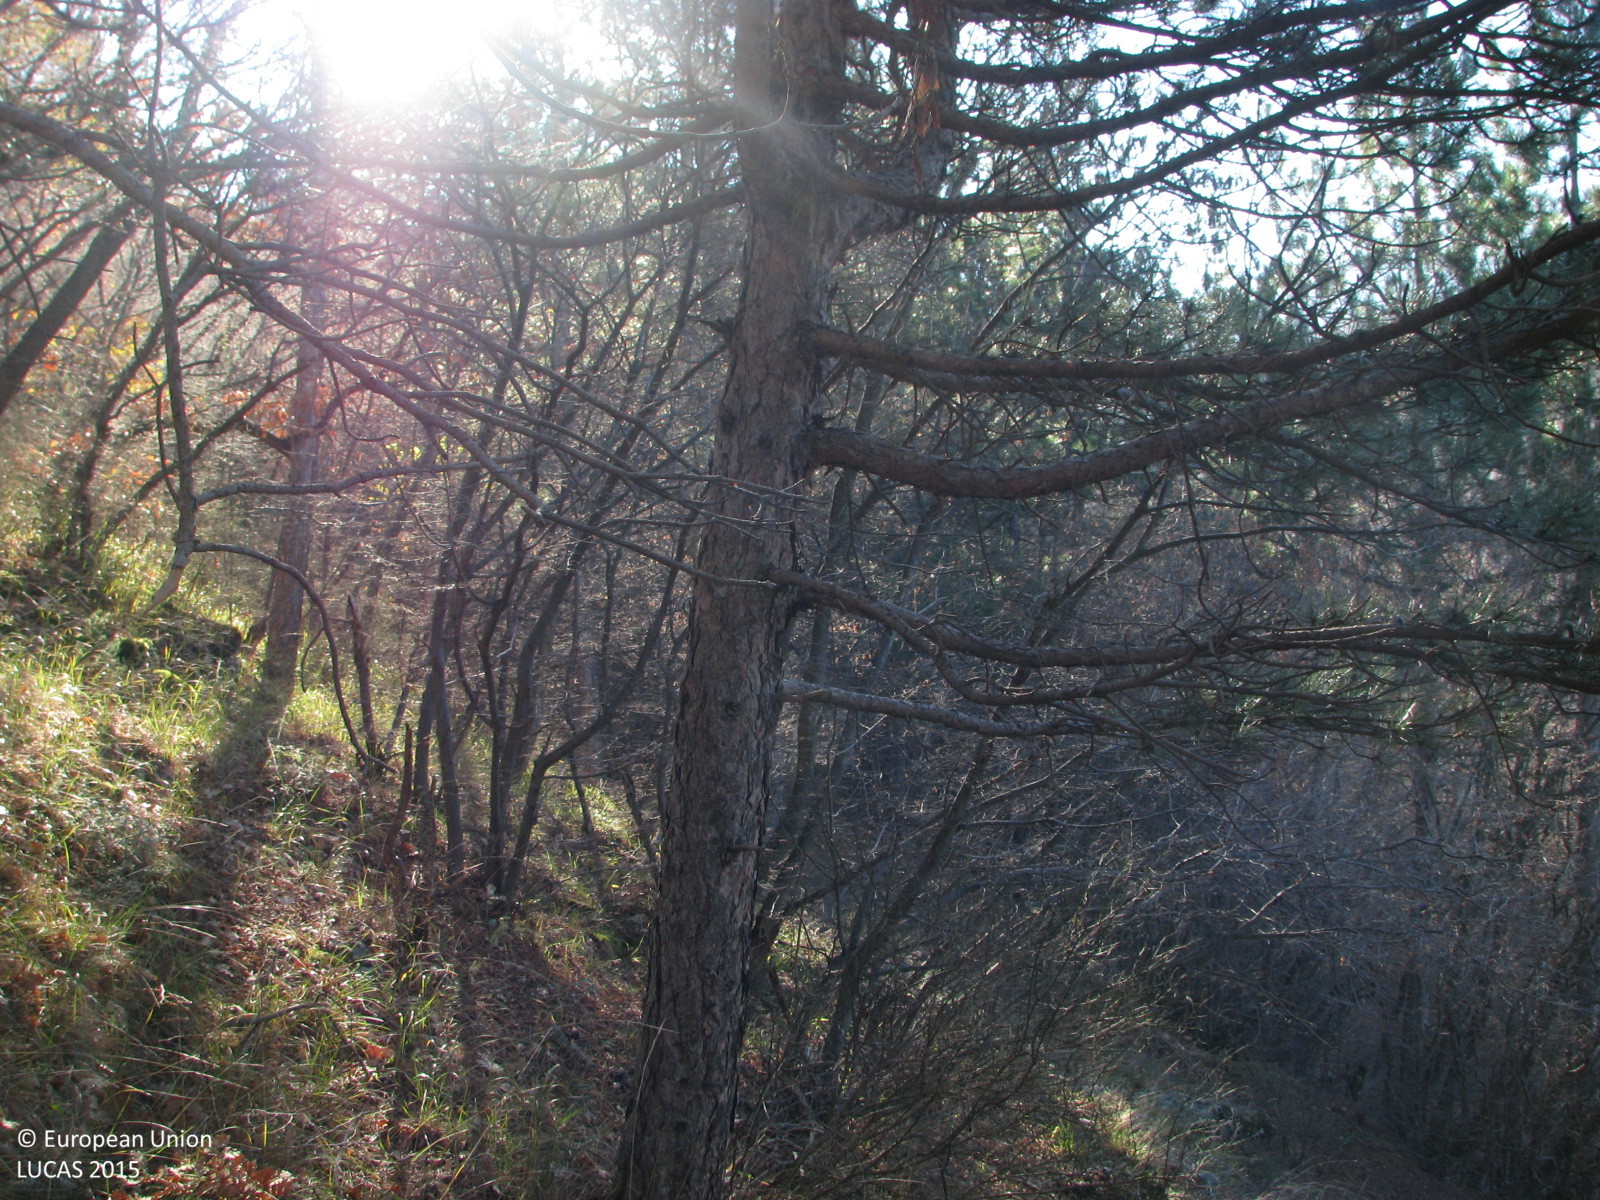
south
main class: Woodland
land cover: Pine dominated mixed woodland
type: hemiboreal forest and nemoral coniferous forest and mixed broadleaved-coniferous forest
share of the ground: > 75 %
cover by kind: coniferous forest trees 40 %, broadleaved forest trees 40 %, herbaceous plants 10 %, shrubs 5 %, unconsolidated bare surface 5 %
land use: Forestry
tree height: > 5 m
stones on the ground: < 10 %
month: December
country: BG
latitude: 42.1052
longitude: 24.2022
